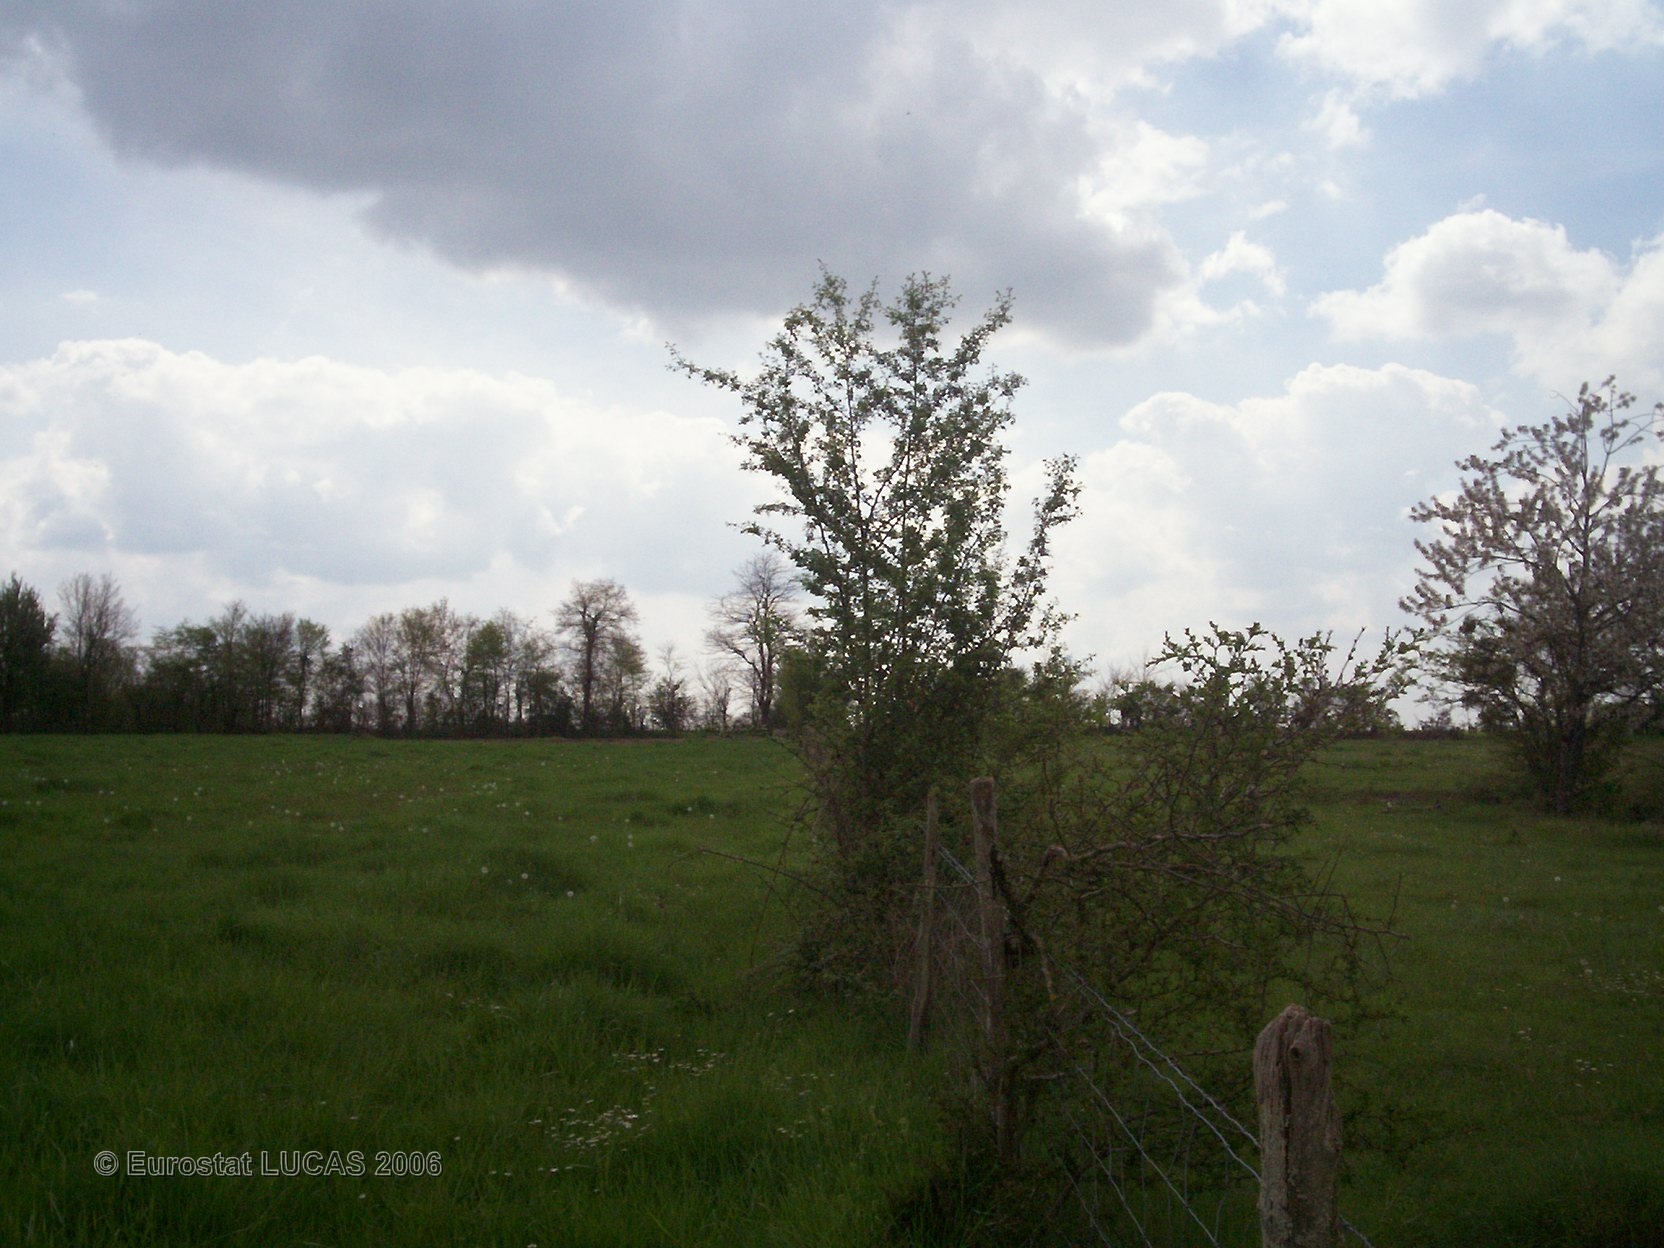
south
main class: Grassland
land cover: Grassland with sparse tree/shrub cover
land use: Agriculture (excluding fallow land and kitchen gardens)
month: April
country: FR
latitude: 46.3633
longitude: 0.5079
